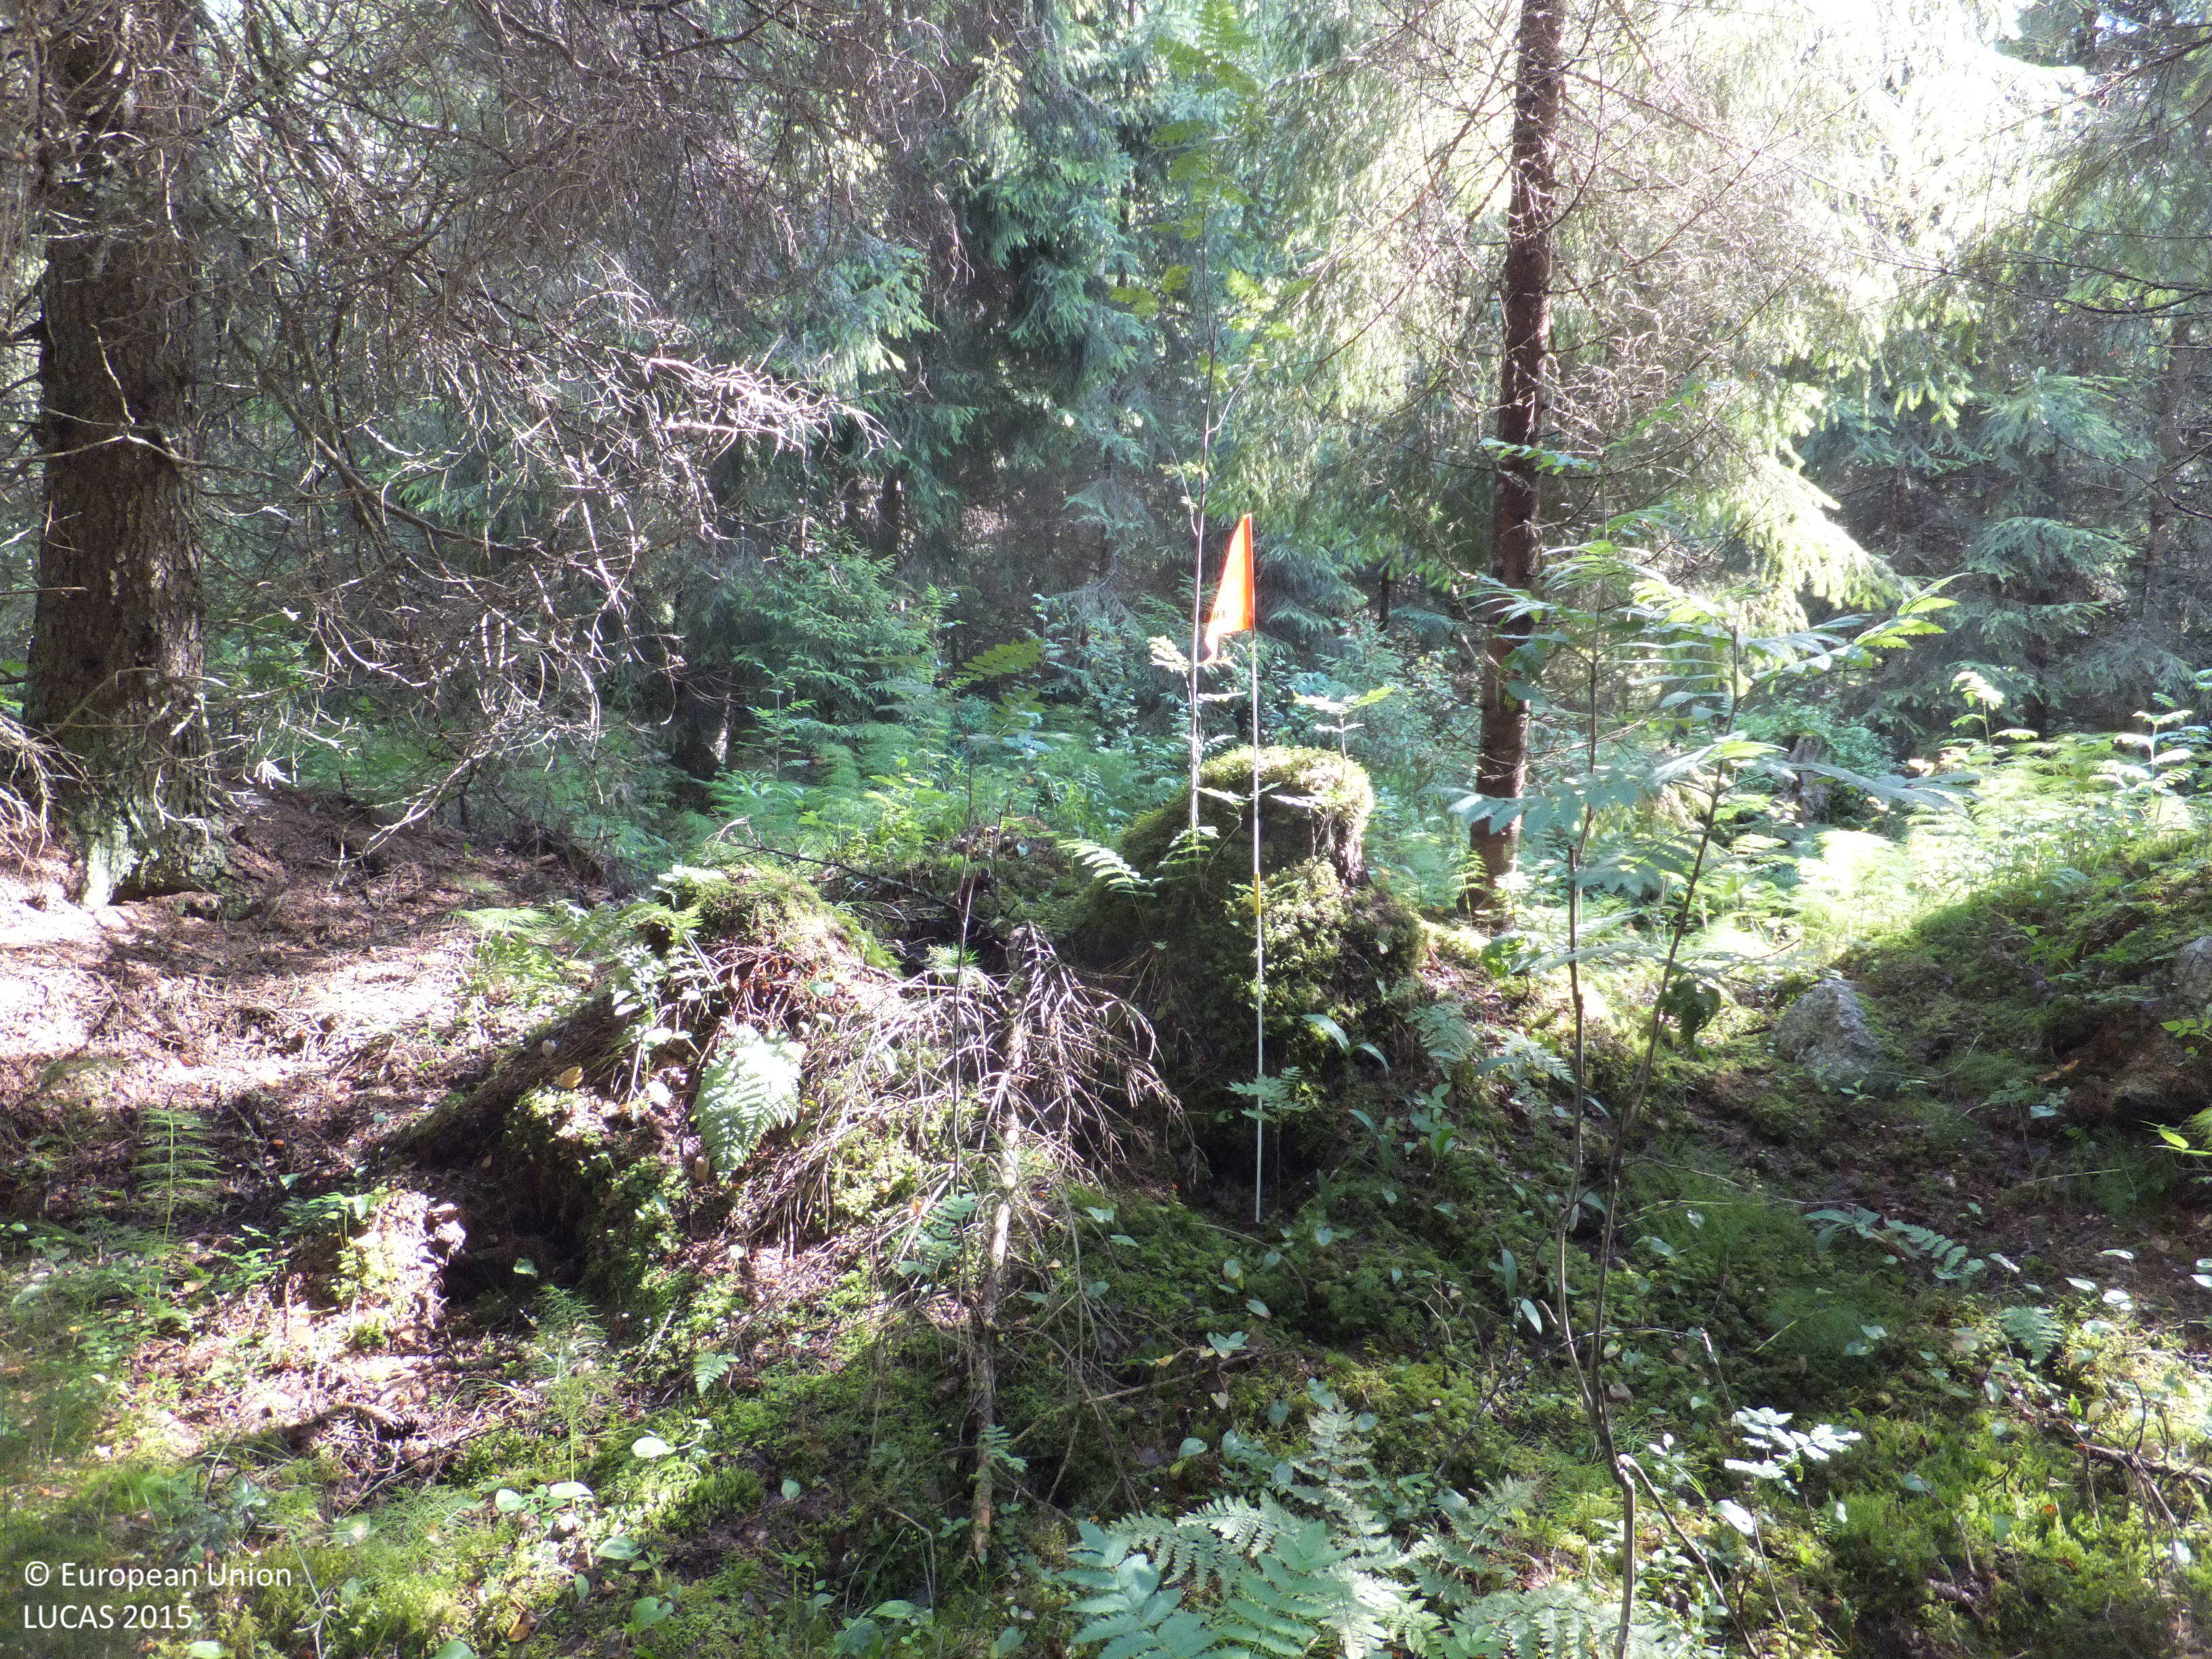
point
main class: Woodland
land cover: Spruce dominated mixed woodland
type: boreal forest
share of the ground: > 75 %
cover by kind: coniferous forest trees 55 %, broadleaved forest trees 30 %, shrubs 5 %, herbaceous plants 5 %, lichens and mosses 5 %
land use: Forestry
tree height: > 5 m
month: August
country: FI
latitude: 63.1233
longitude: 22.1606
